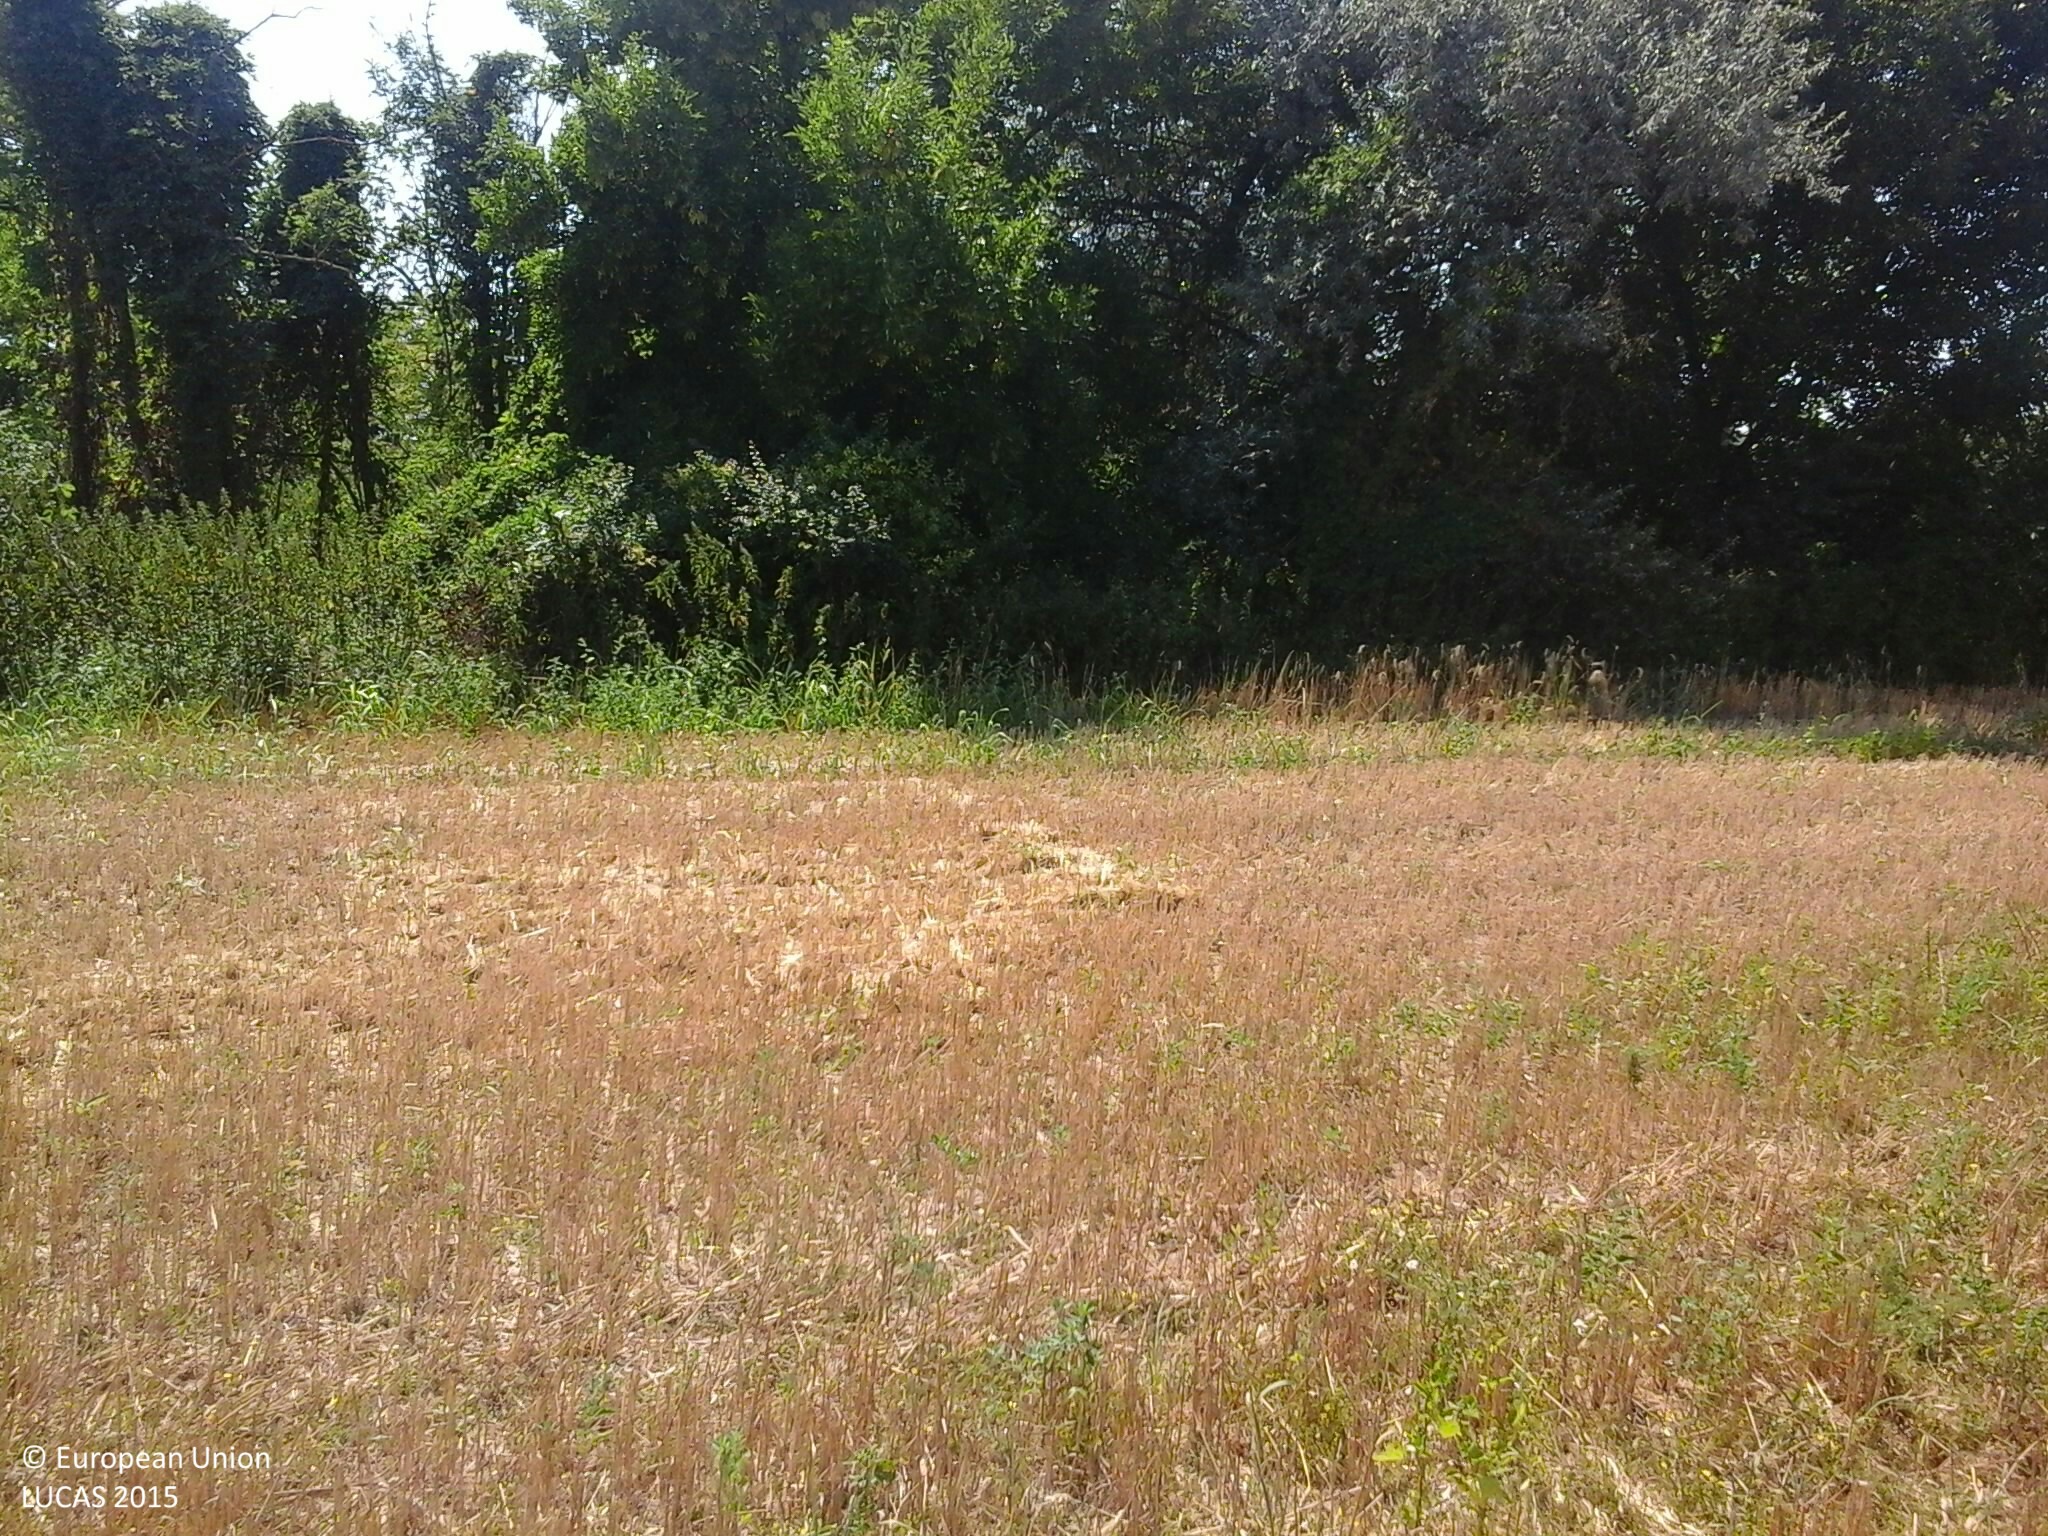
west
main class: Cropland
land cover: Common wheat
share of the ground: 25 - 50 %
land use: Agriculture (excluding fallow land and kitchen gardens)
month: July
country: HU
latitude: 47.0406
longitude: 18.3158
